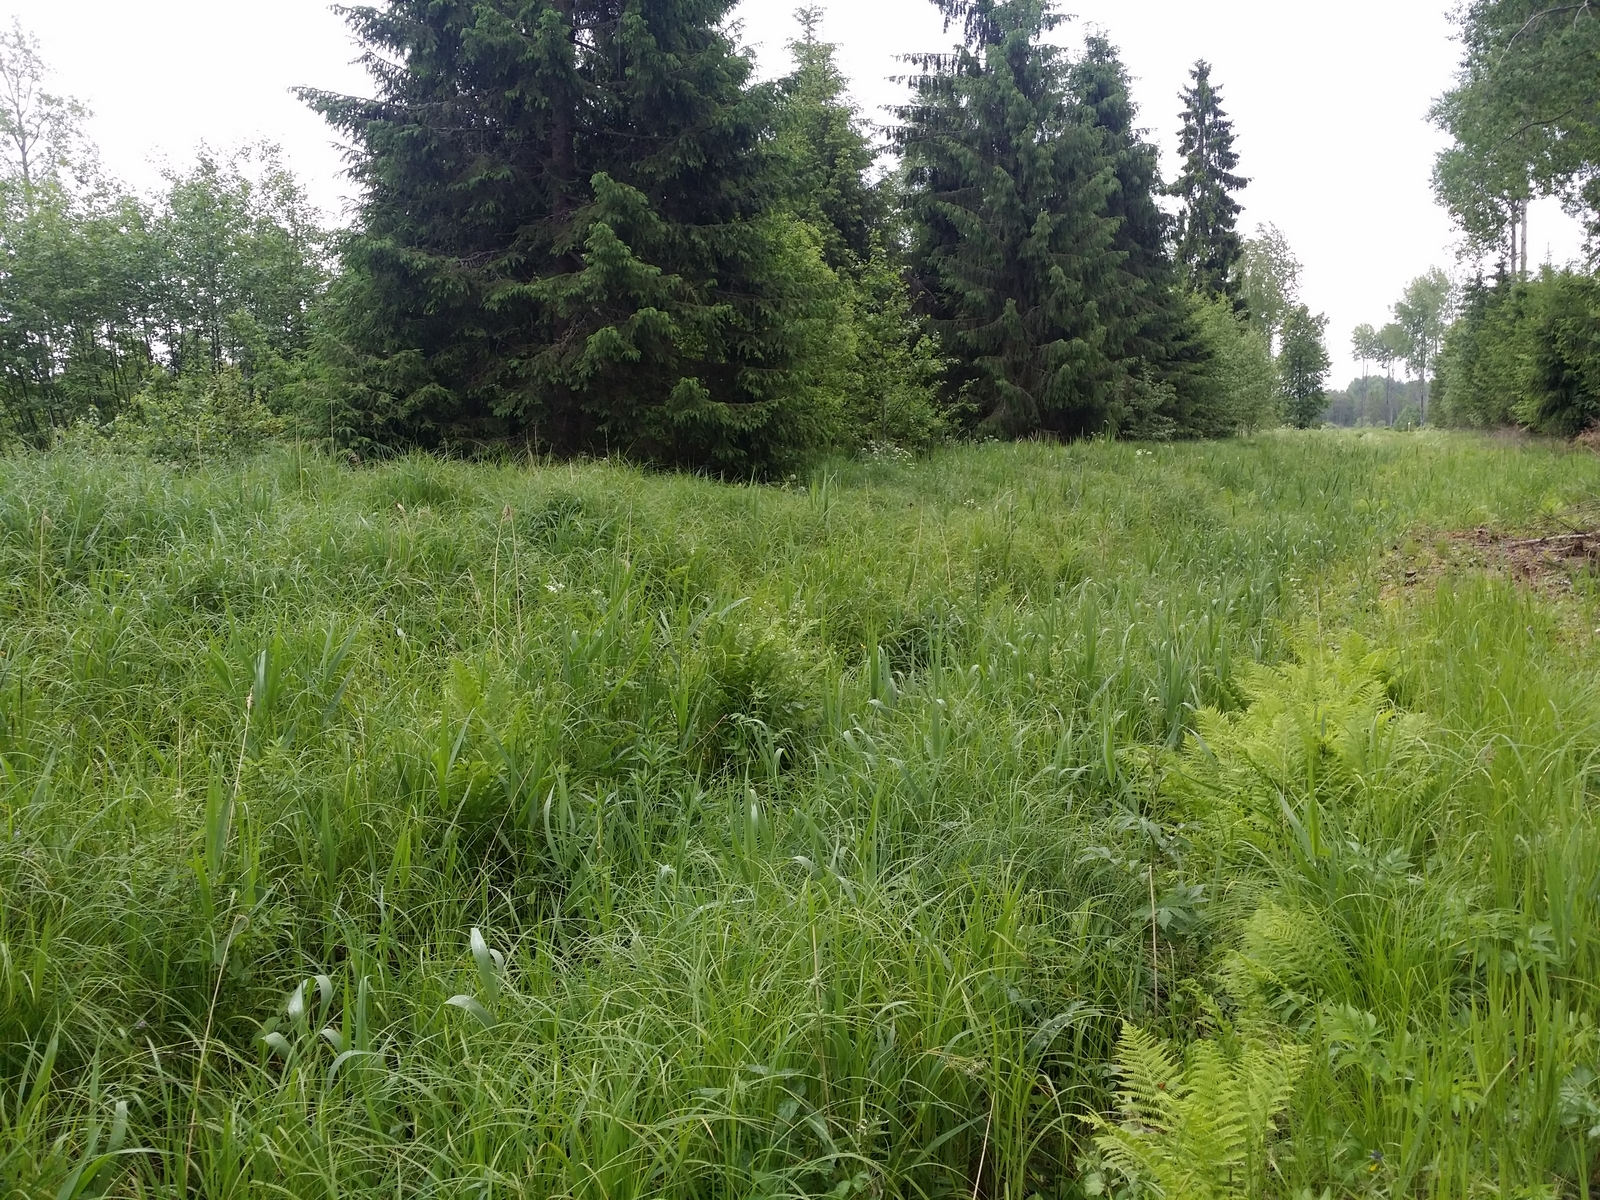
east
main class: Grassland
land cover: Spontaneously vegetated surfaces
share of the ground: > 75 %
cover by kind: herbaceous plants 95 %, shrubs 5 %
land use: Forestry
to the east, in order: Spontaneously vegetated surfaces; Spruce dominated mixed woodland; Grassland with sparse tree/shrub cover; Spruce dominated mixed woodland; Broadleaved woodland; Grassland with sparse tree/shrub cover
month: June
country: LV
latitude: 57.5175
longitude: 26.5211
